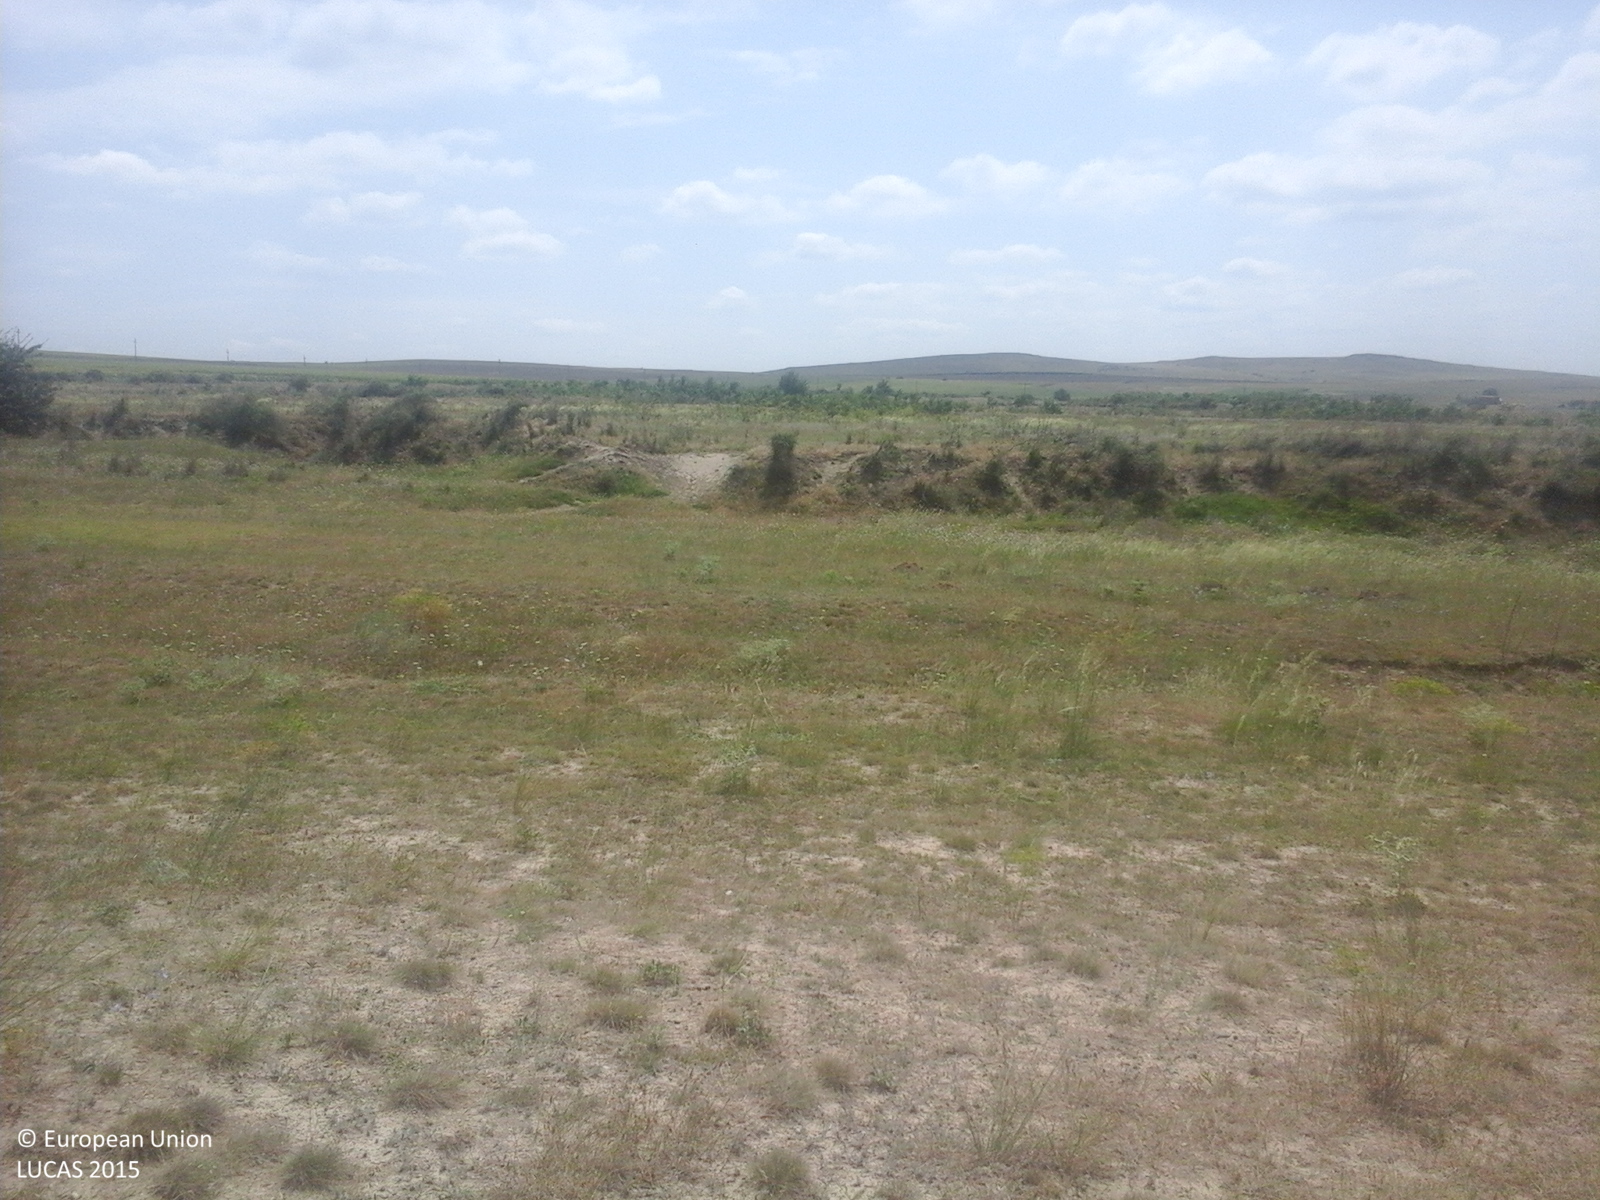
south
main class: Grassland
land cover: Grassland without tree/shrub cover
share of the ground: 50 - 75 %
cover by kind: herbaceous plants 100 %
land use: Agriculture (excluding fallow land and kitchen gardens)
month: August
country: RO
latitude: 44.7770
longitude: 28.2786
